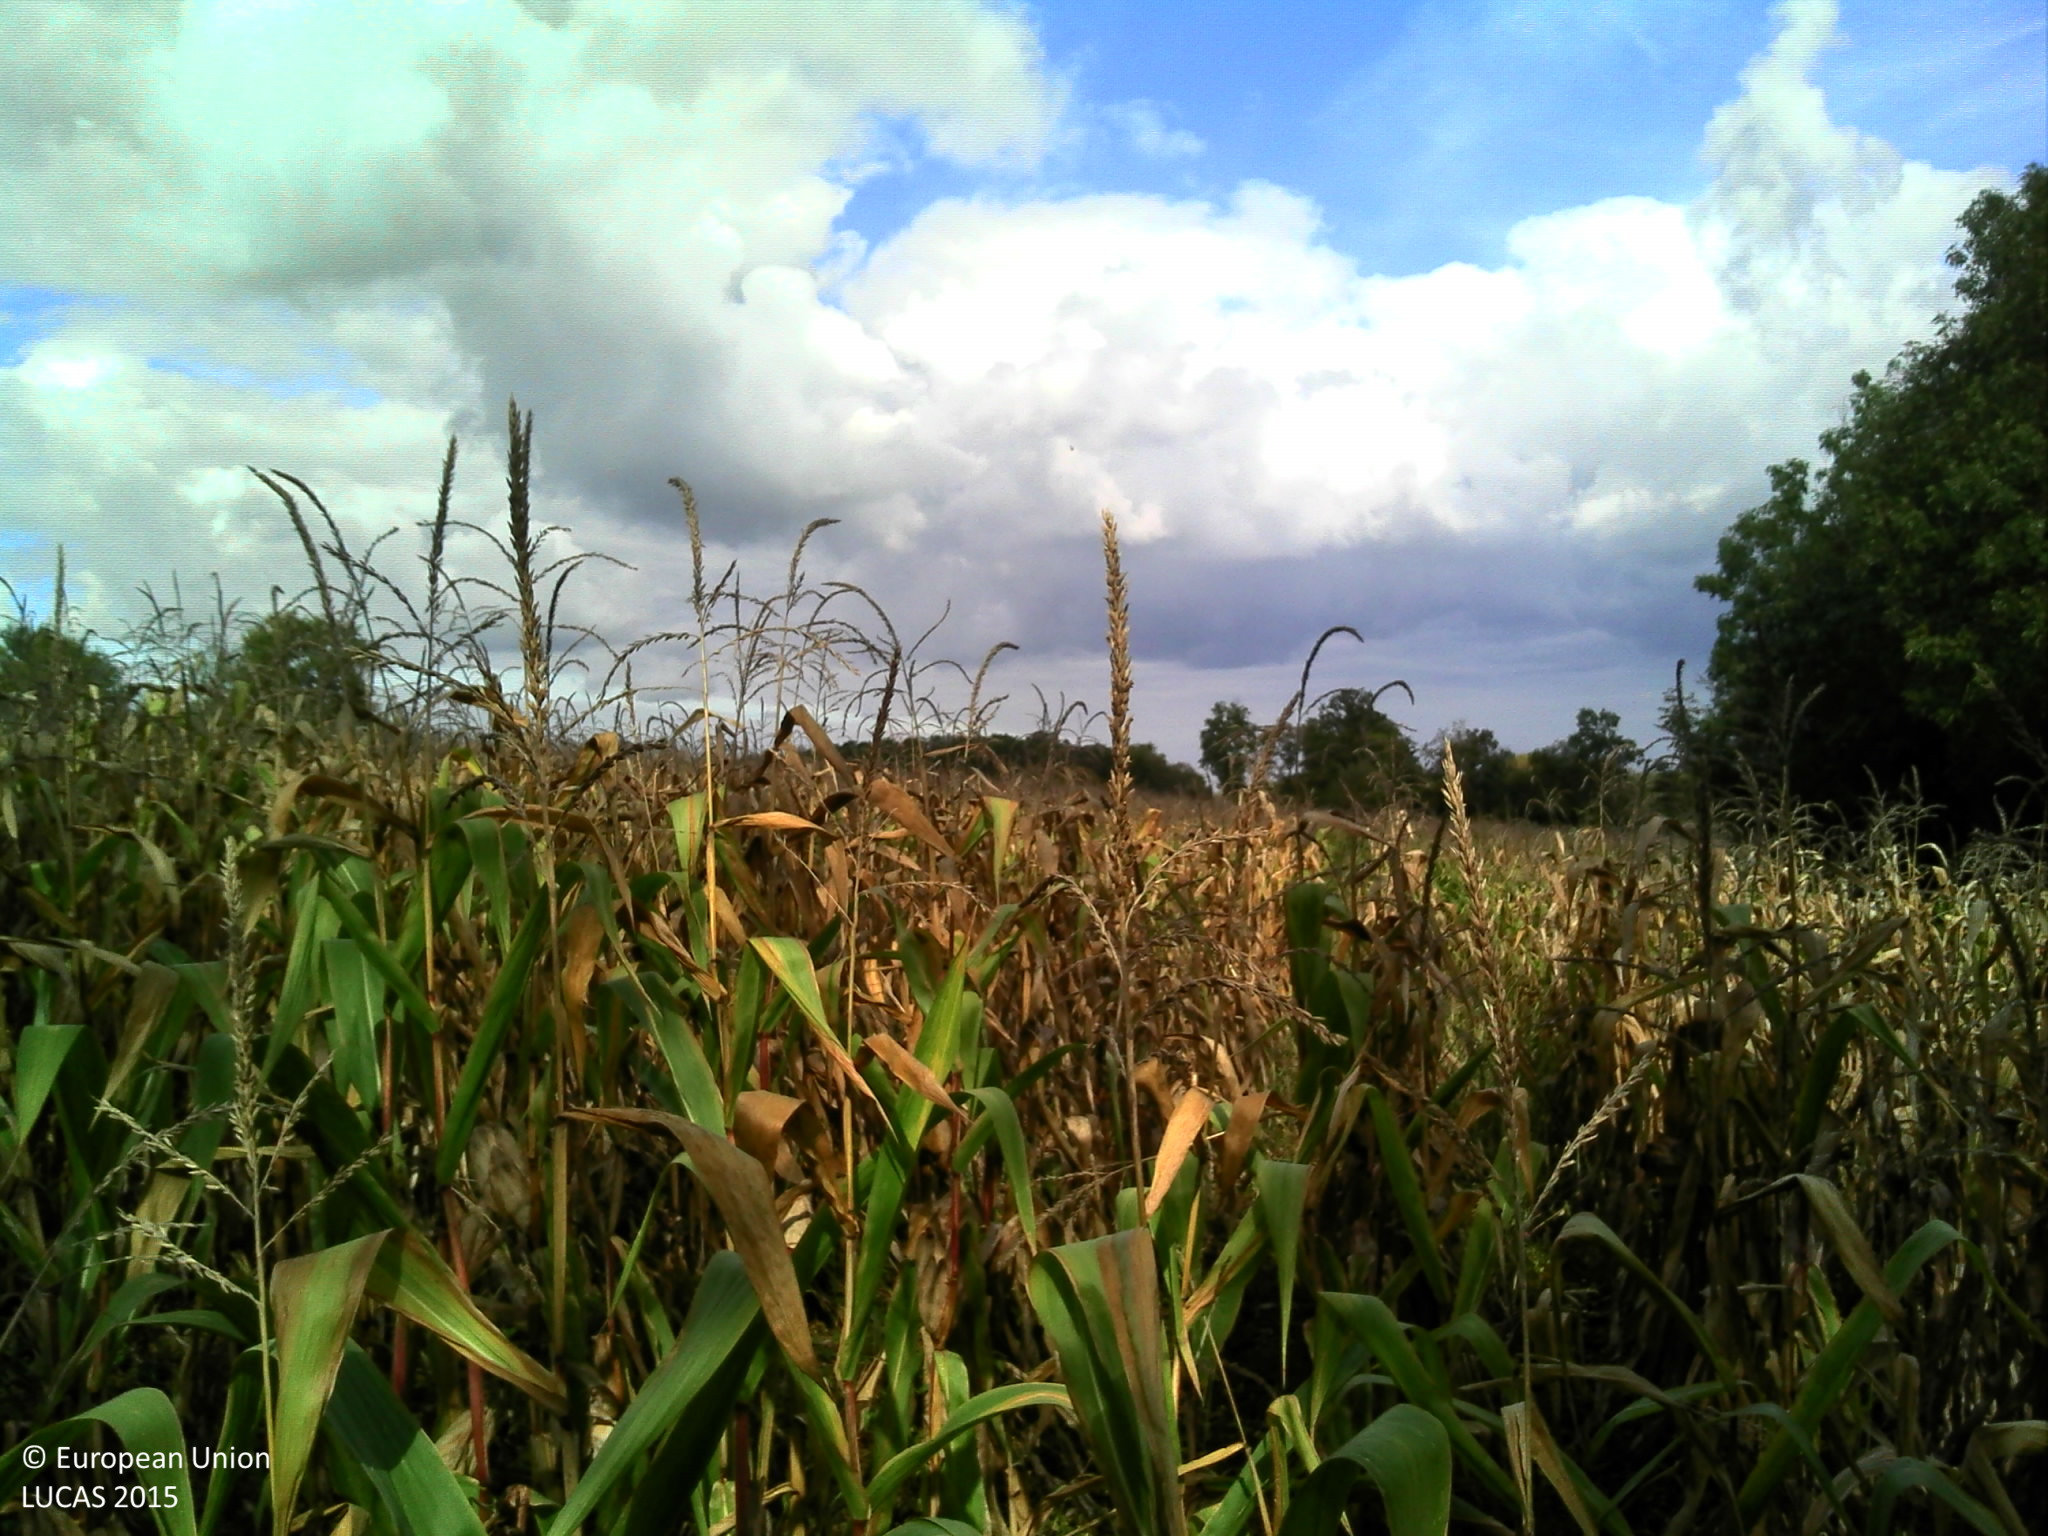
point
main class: Cropland
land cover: Maize
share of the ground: > 75 %
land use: Agriculture (excluding fallow land and kitchen gardens)
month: October
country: FR
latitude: 46.3642
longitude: 5.0763
